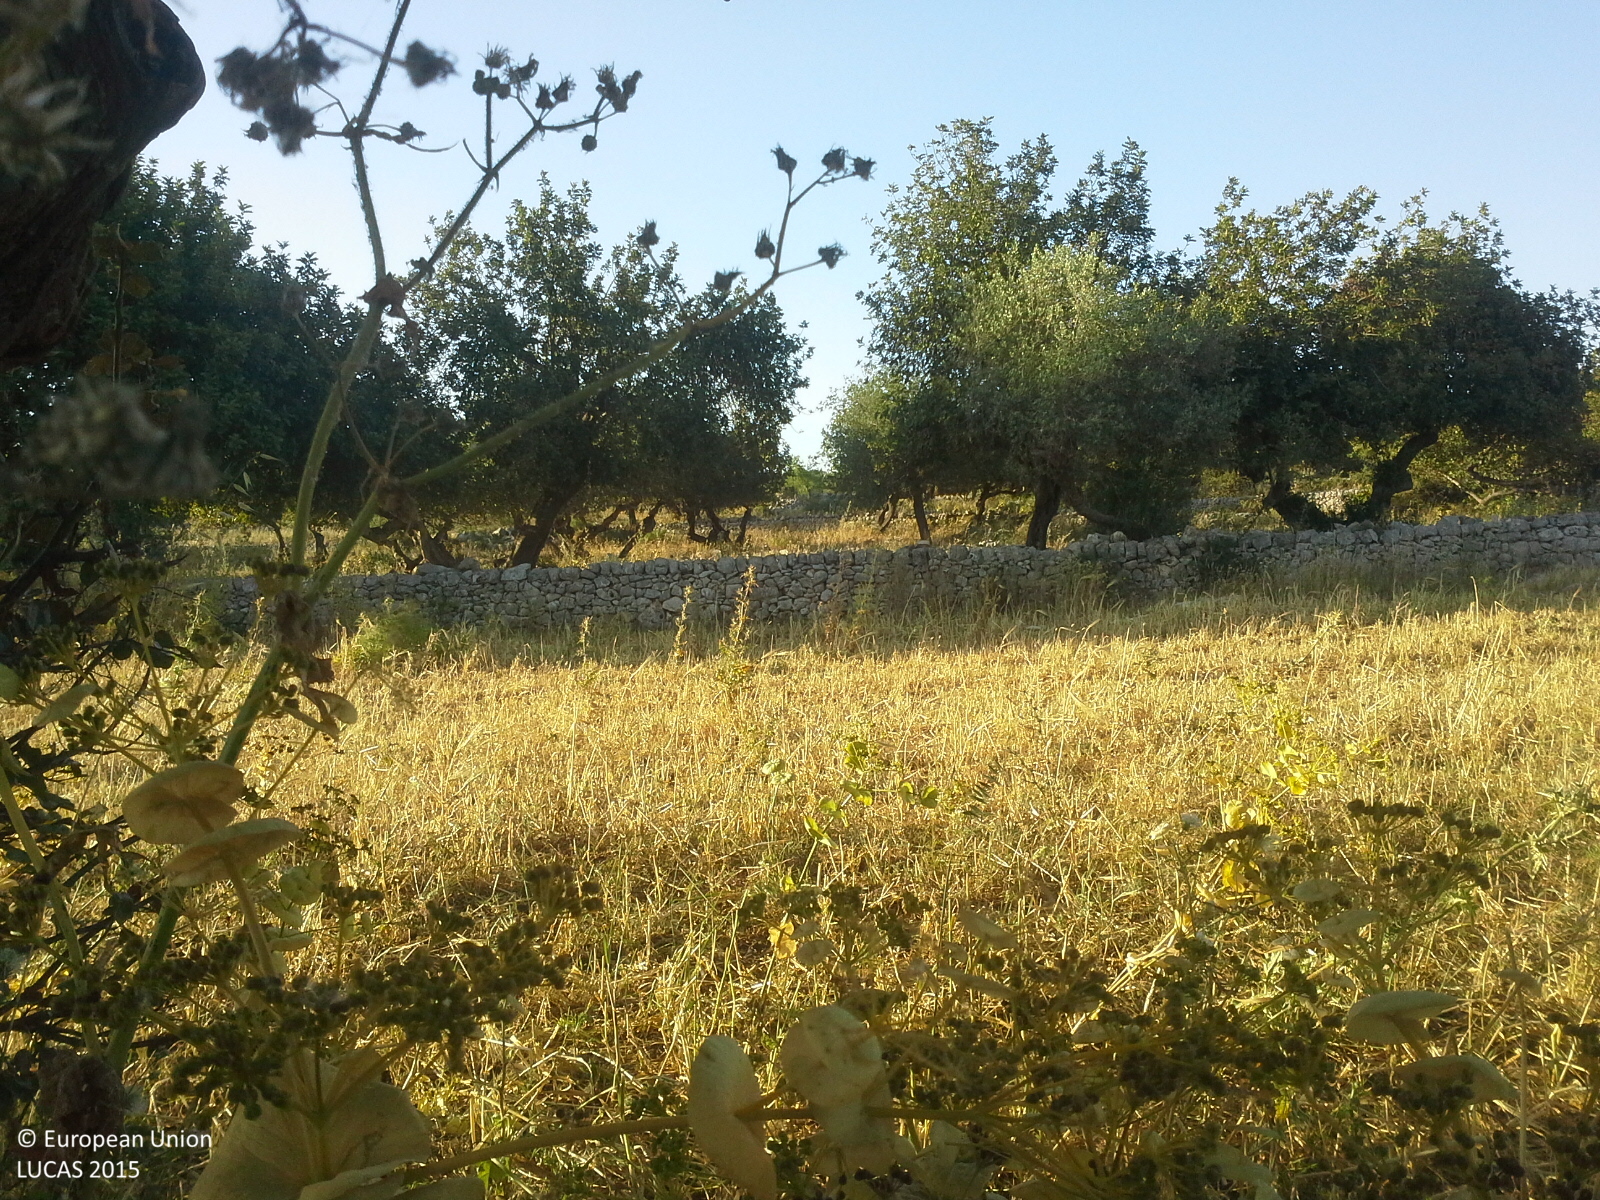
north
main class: Cropland
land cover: Permanent industrial crops
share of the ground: > 75 %
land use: Agriculture (excluding fallow land and kitchen gardens)
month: May
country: IT
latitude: 36.7866
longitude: 14.8578
